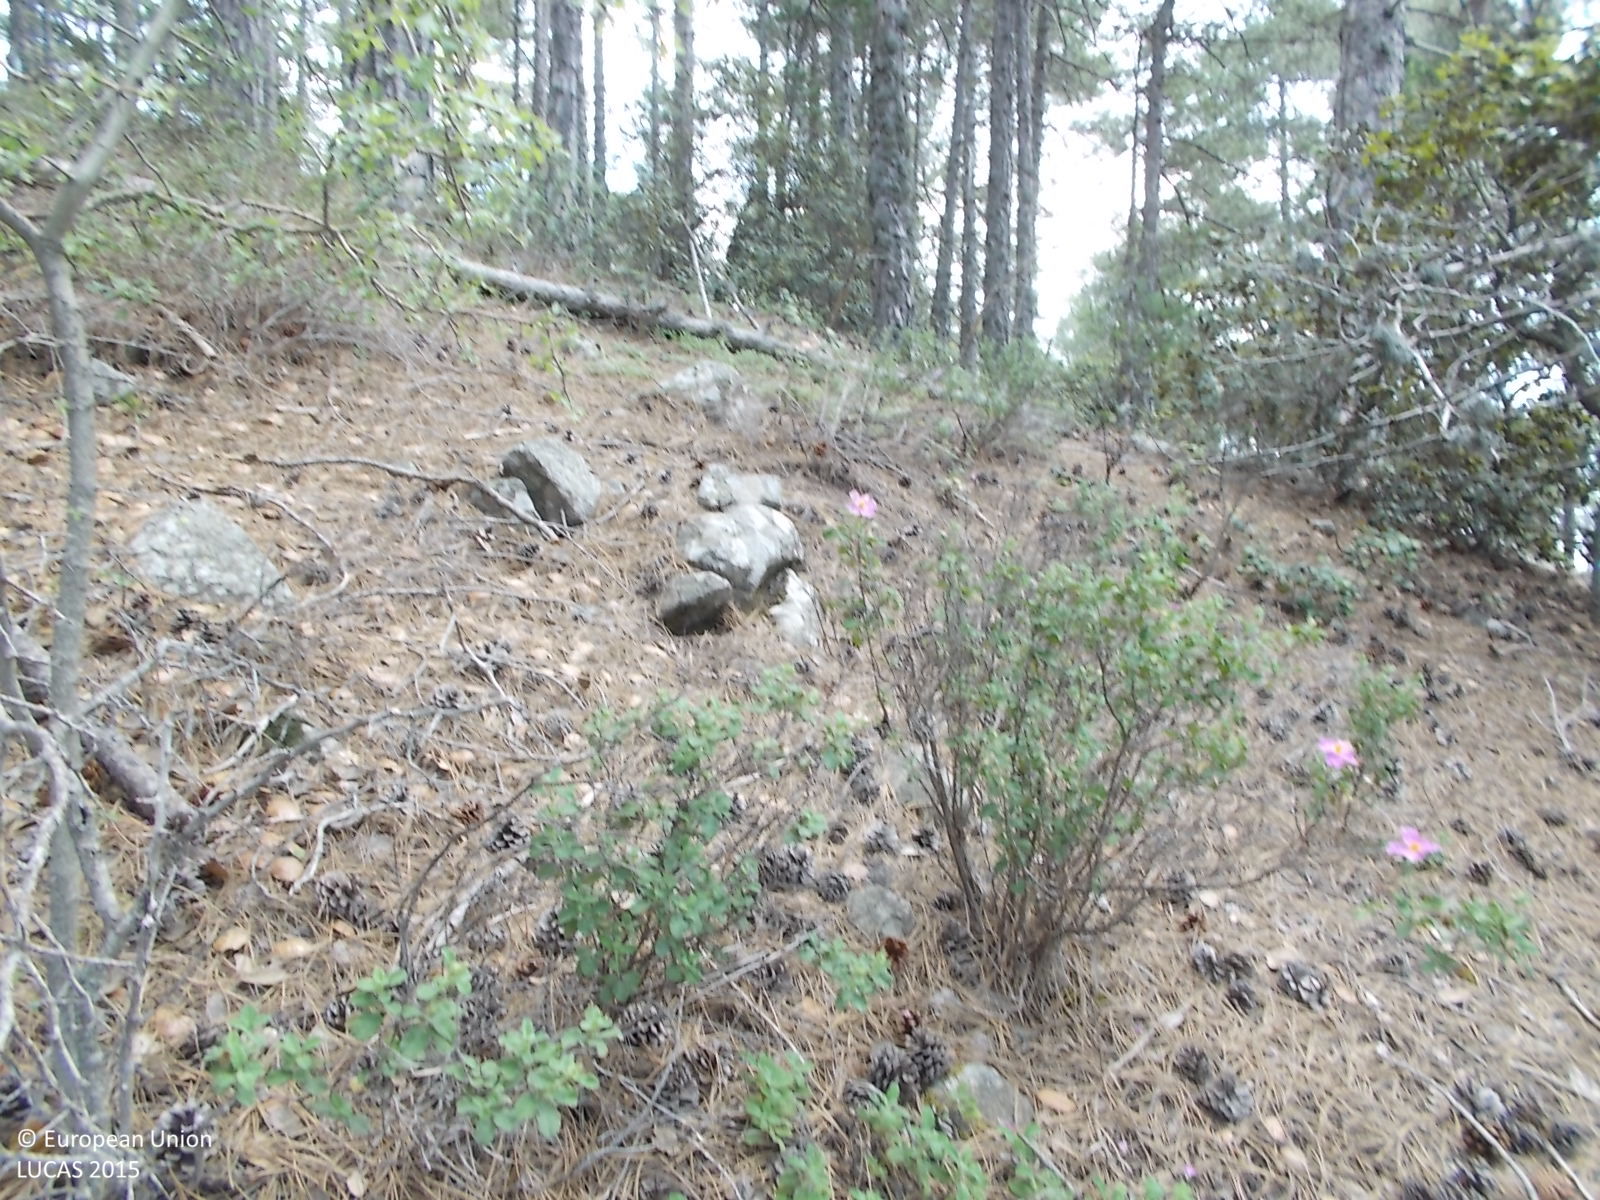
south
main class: Woodland
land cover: Pine dominated mixed woodland
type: coniferous forest of the mediterranean region
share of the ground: > 75 %
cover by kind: coniferous forest trees 70 %, broadleaved forest trees 25 %, shrubs 5 %
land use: Forestry
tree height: > 5 m
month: June
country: CY
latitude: 34.9292
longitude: 32.8372
